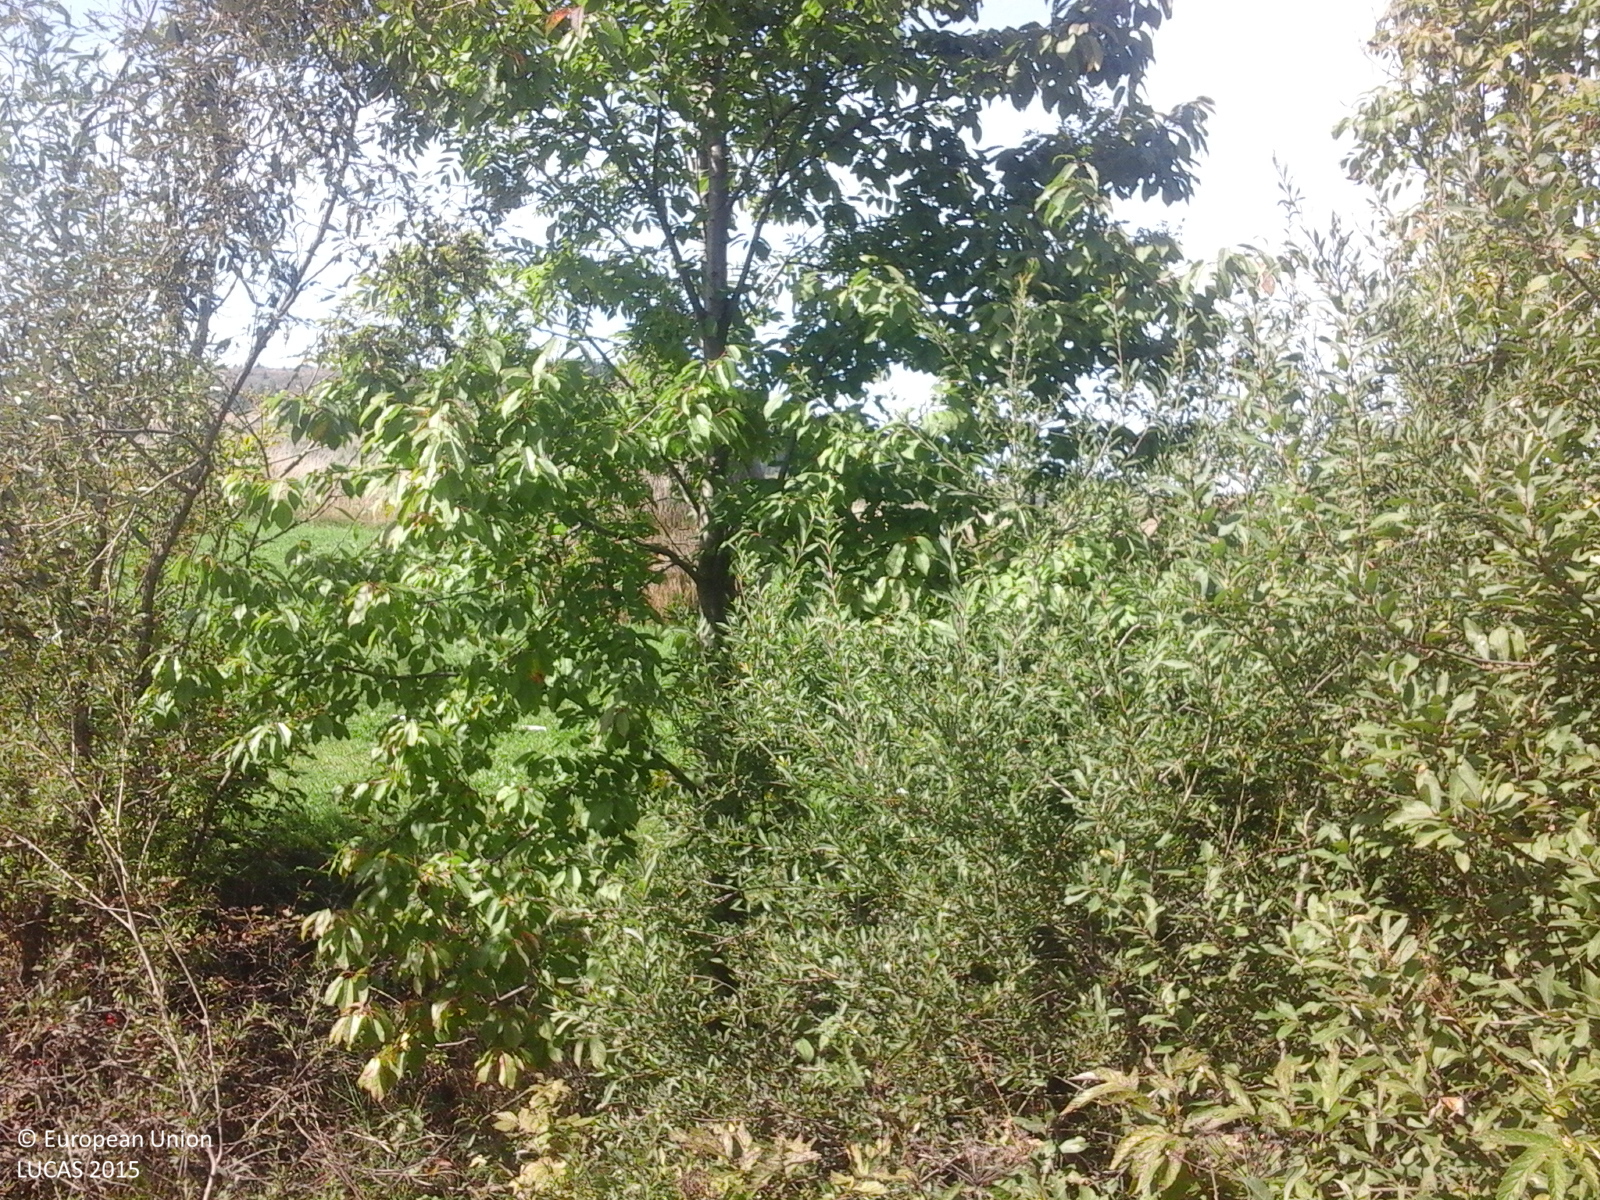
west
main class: Shrubland
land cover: Shrubland without tree cover
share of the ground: > 75 %
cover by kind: shrubs 100 %
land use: Fallow land
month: September
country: RO
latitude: 46.7644
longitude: 23.0906
